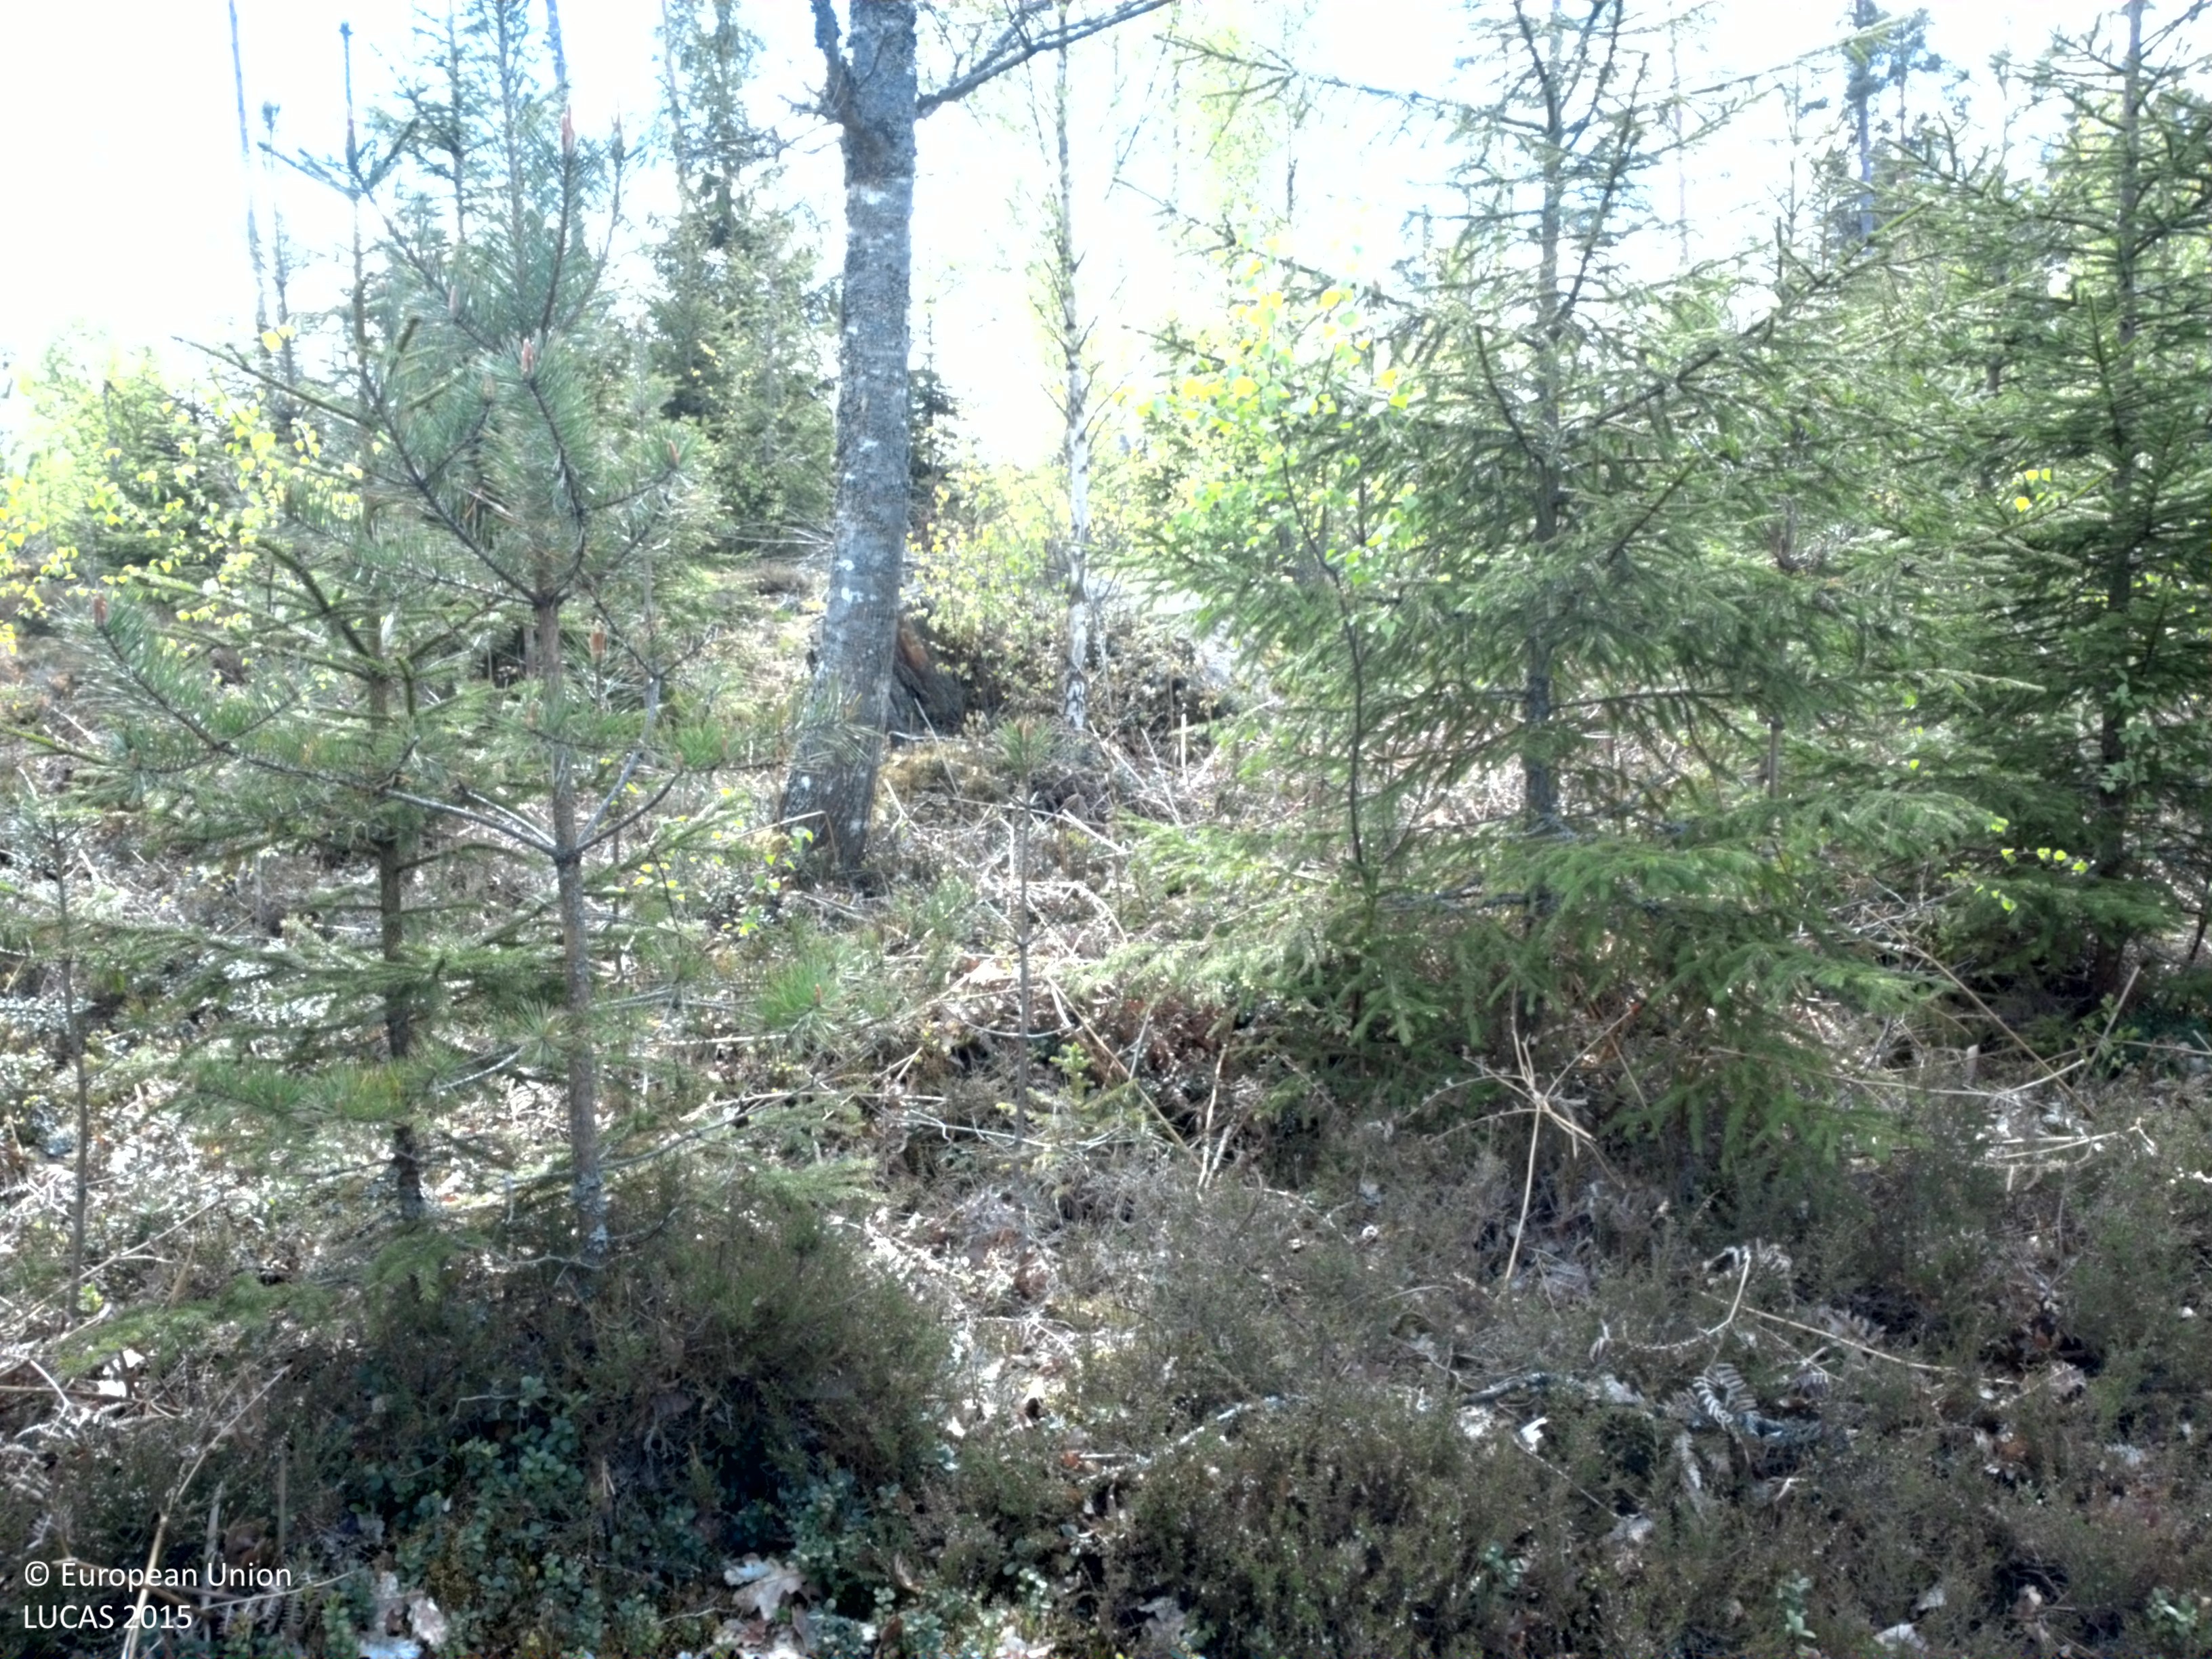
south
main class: Woodland
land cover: Spruce dominated mixed woodland
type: boreal forest
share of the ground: > 75 %
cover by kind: coniferous forest trees 75 %, broadleaved forest trees 25 %
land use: Forestry
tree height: < 5 m
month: May
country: SE
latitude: 56.4539
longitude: 15.3695
